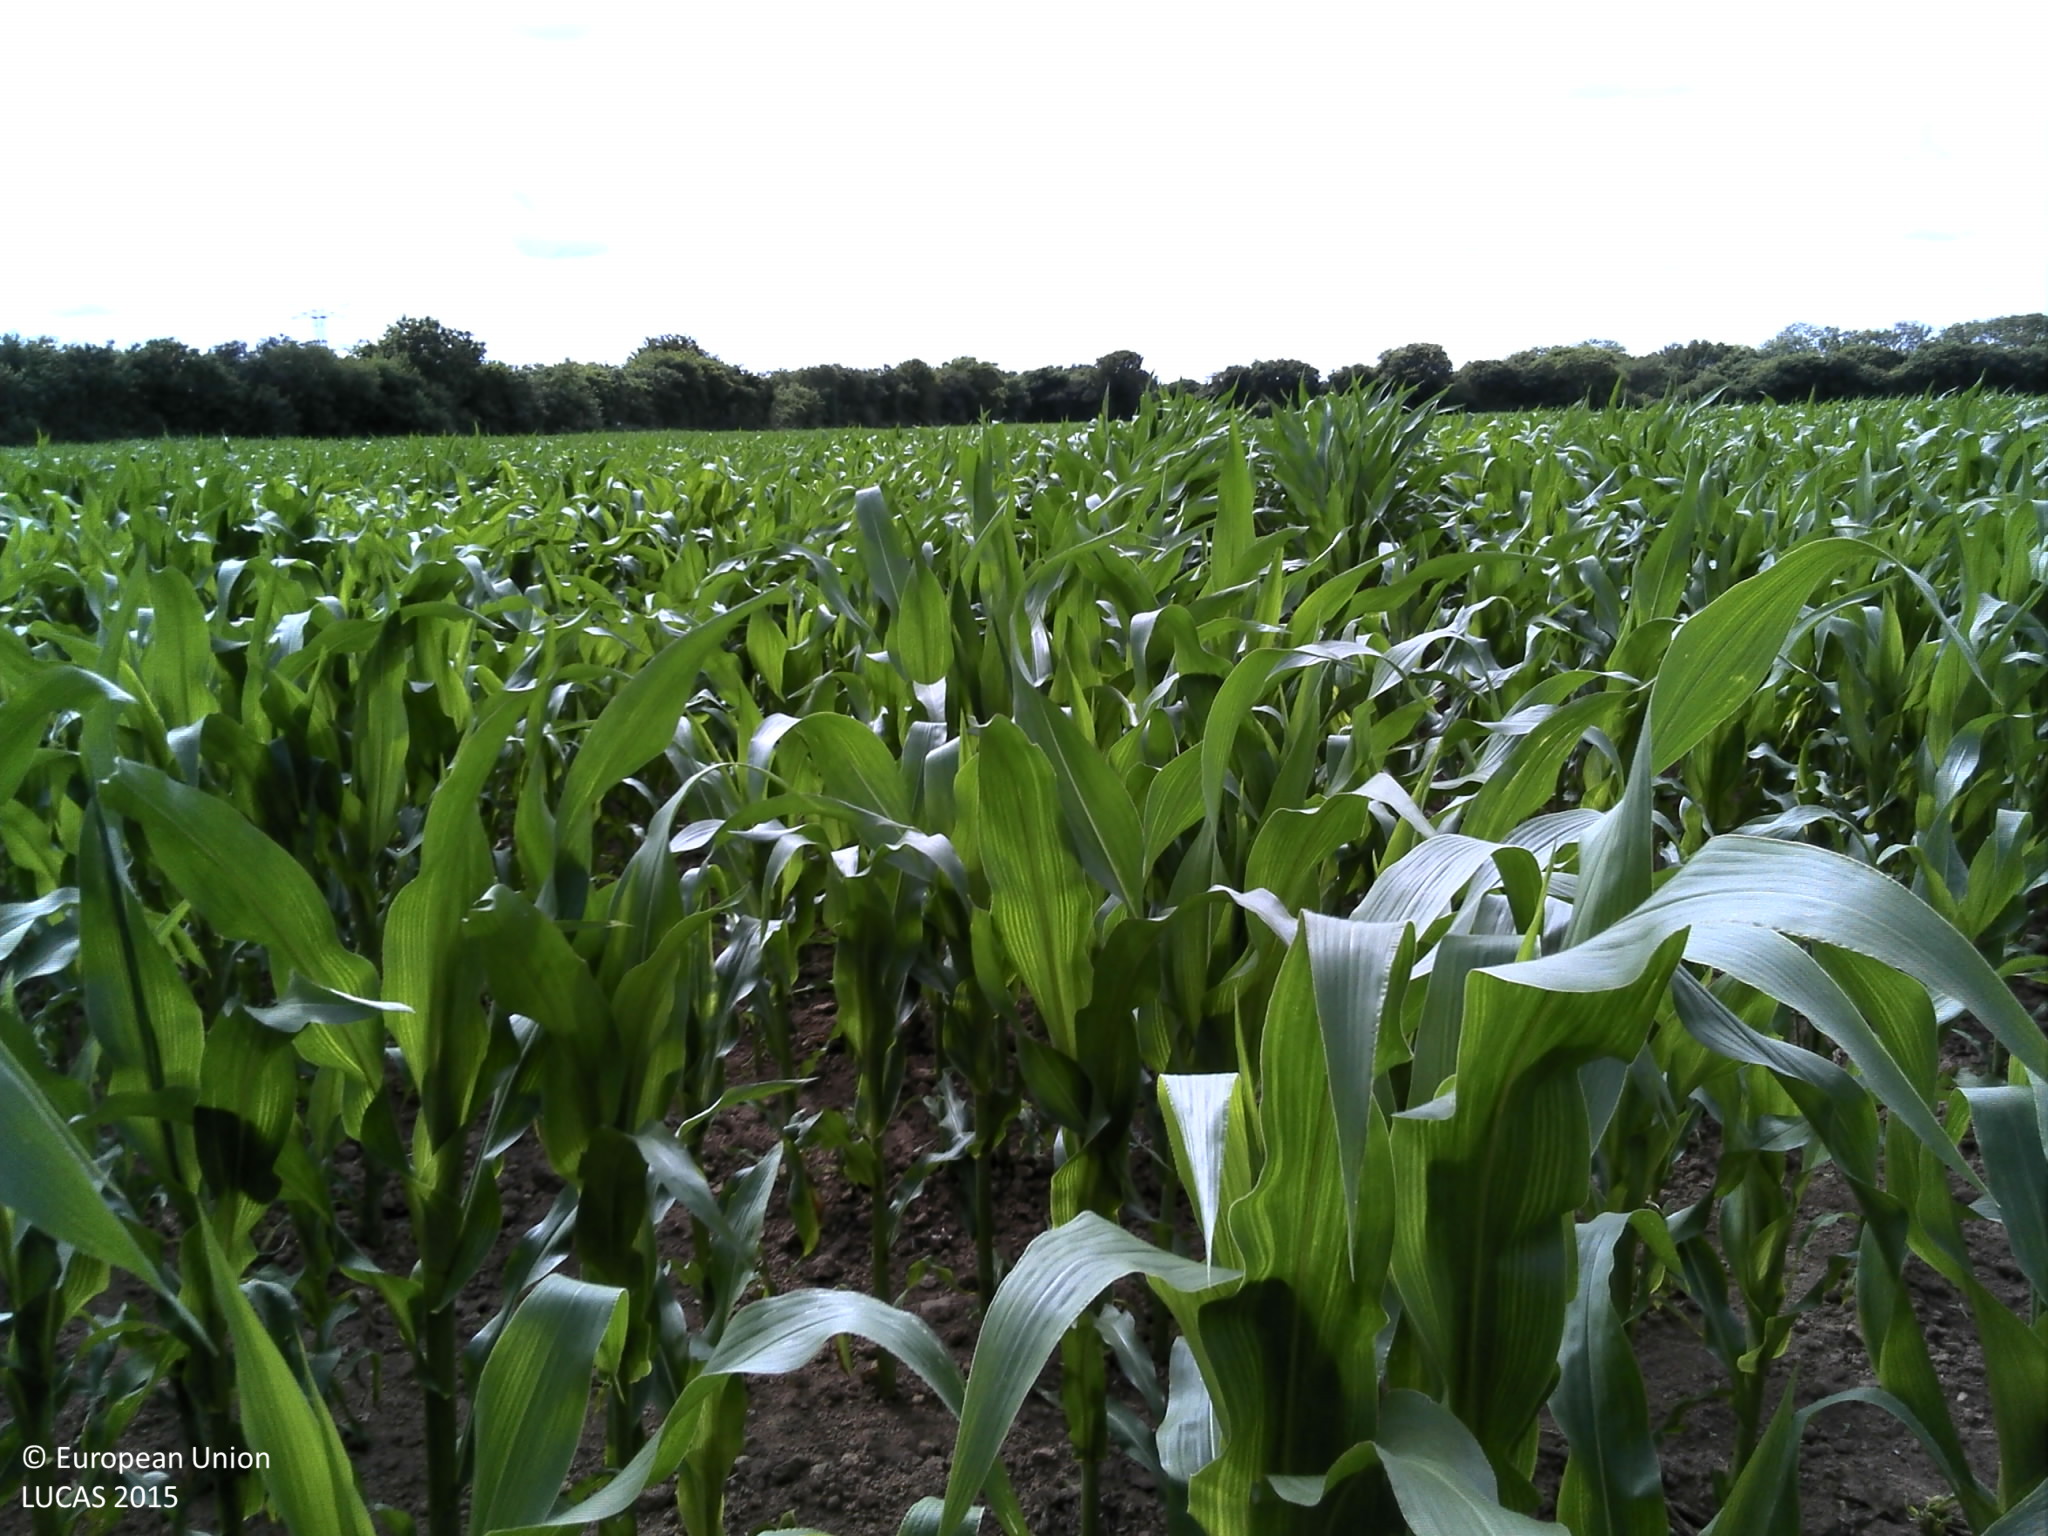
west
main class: Cropland
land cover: Maize
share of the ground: > 75 %
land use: Agriculture (excluding fallow land and kitchen gardens)
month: July
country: FR
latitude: 48.4539
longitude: -4.5821
